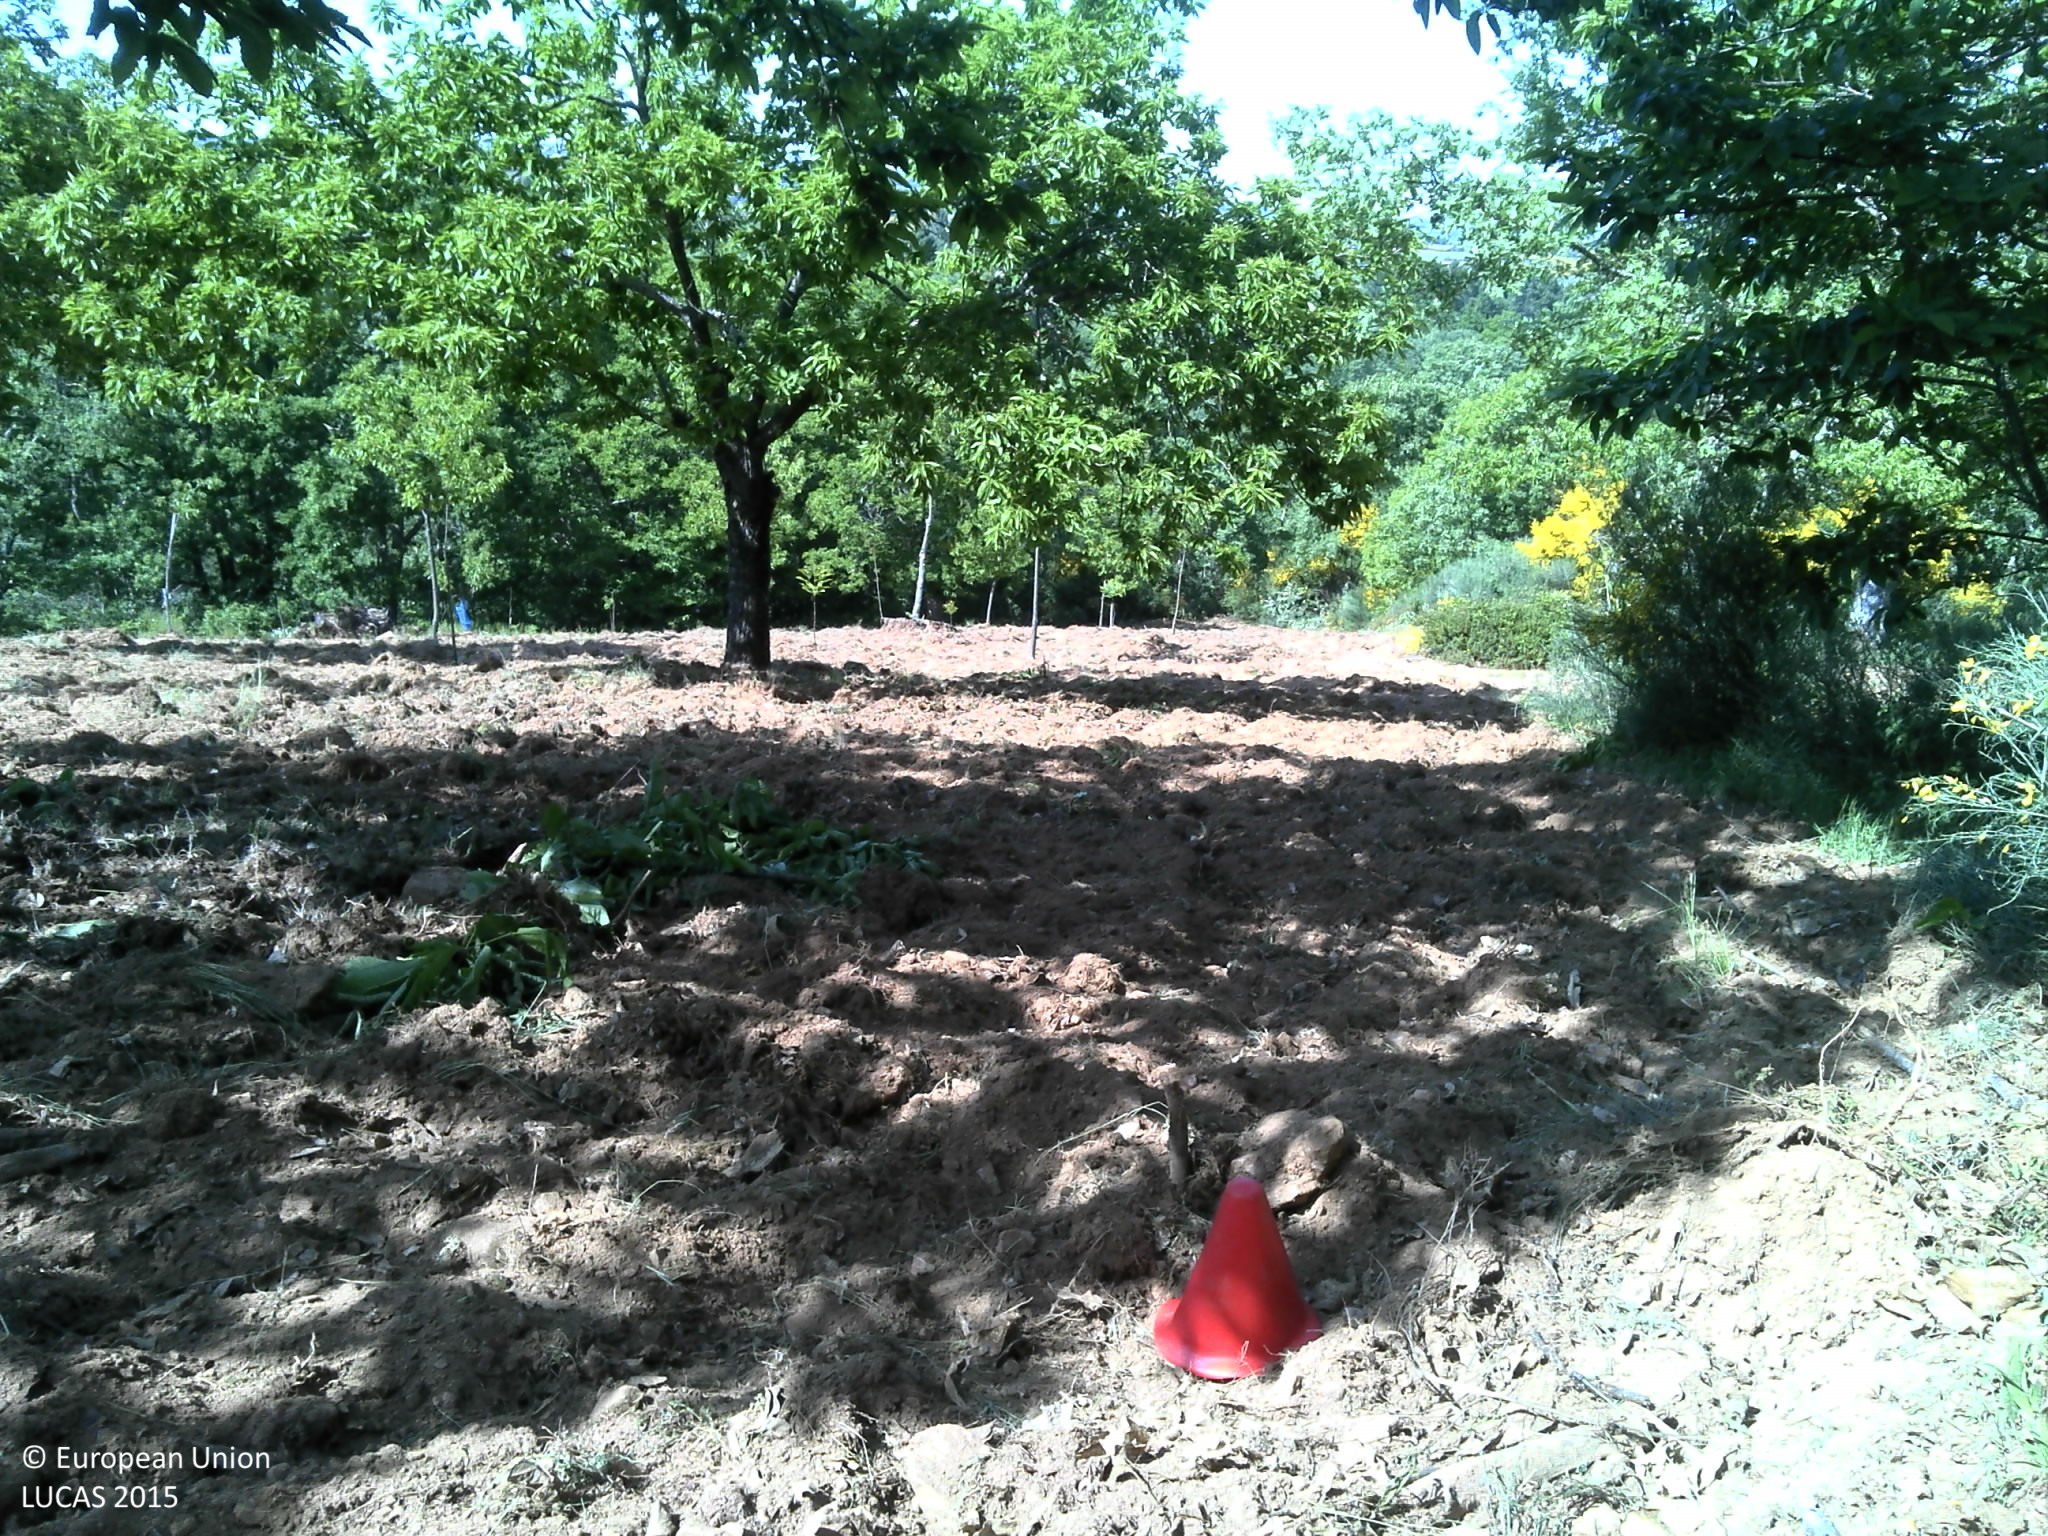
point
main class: Cropland
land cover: Nuts trees
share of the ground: 25 - 50 %
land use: Agriculture (excluding fallow land and kitchen gardens)
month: May
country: PT
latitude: 41.7145
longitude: -7.3502
